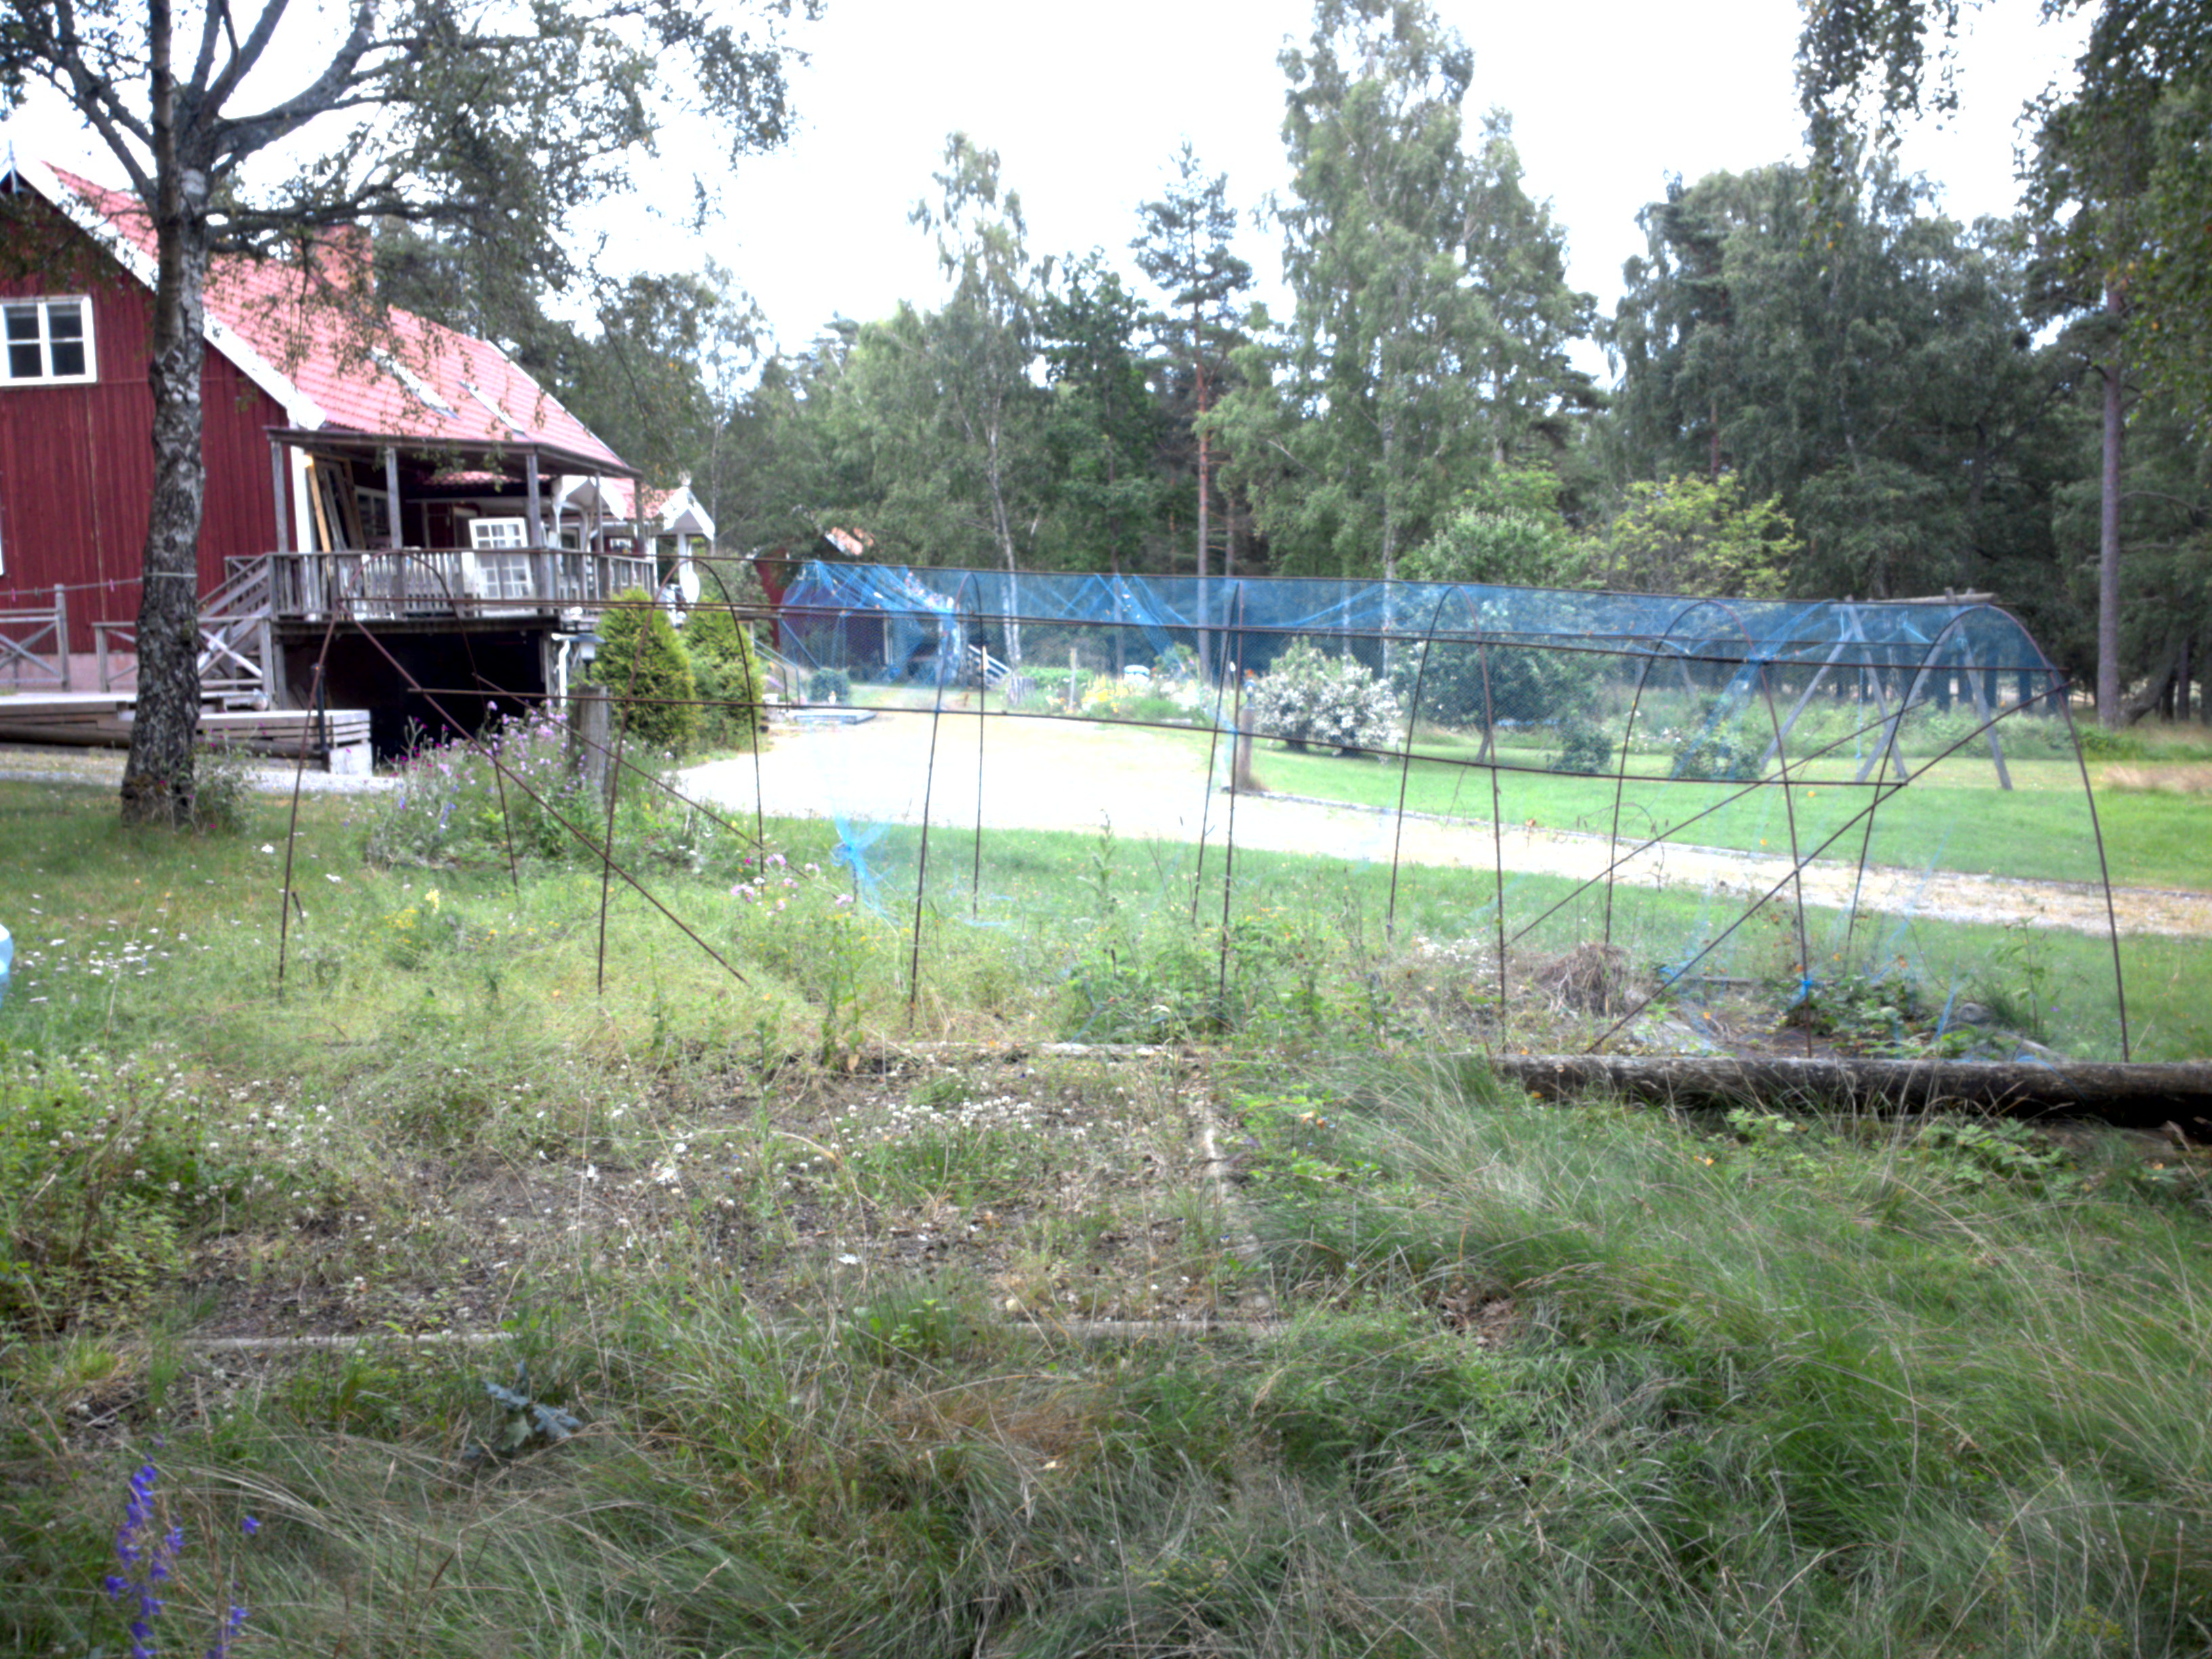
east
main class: Woodland
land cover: Broadleaved woodland
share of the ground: 50 - 75 %
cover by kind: broadleaved forest trees 55 %, herbaceous plants 35 %, coniferous forest trees 10 %
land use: Residential
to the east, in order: Broadleaved woodland; Artificial constructions in urban areas; Pine dominated coniferous woodland; Grassland without tree/shrub cover
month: July
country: SE
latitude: 59.1347
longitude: 18.3720
